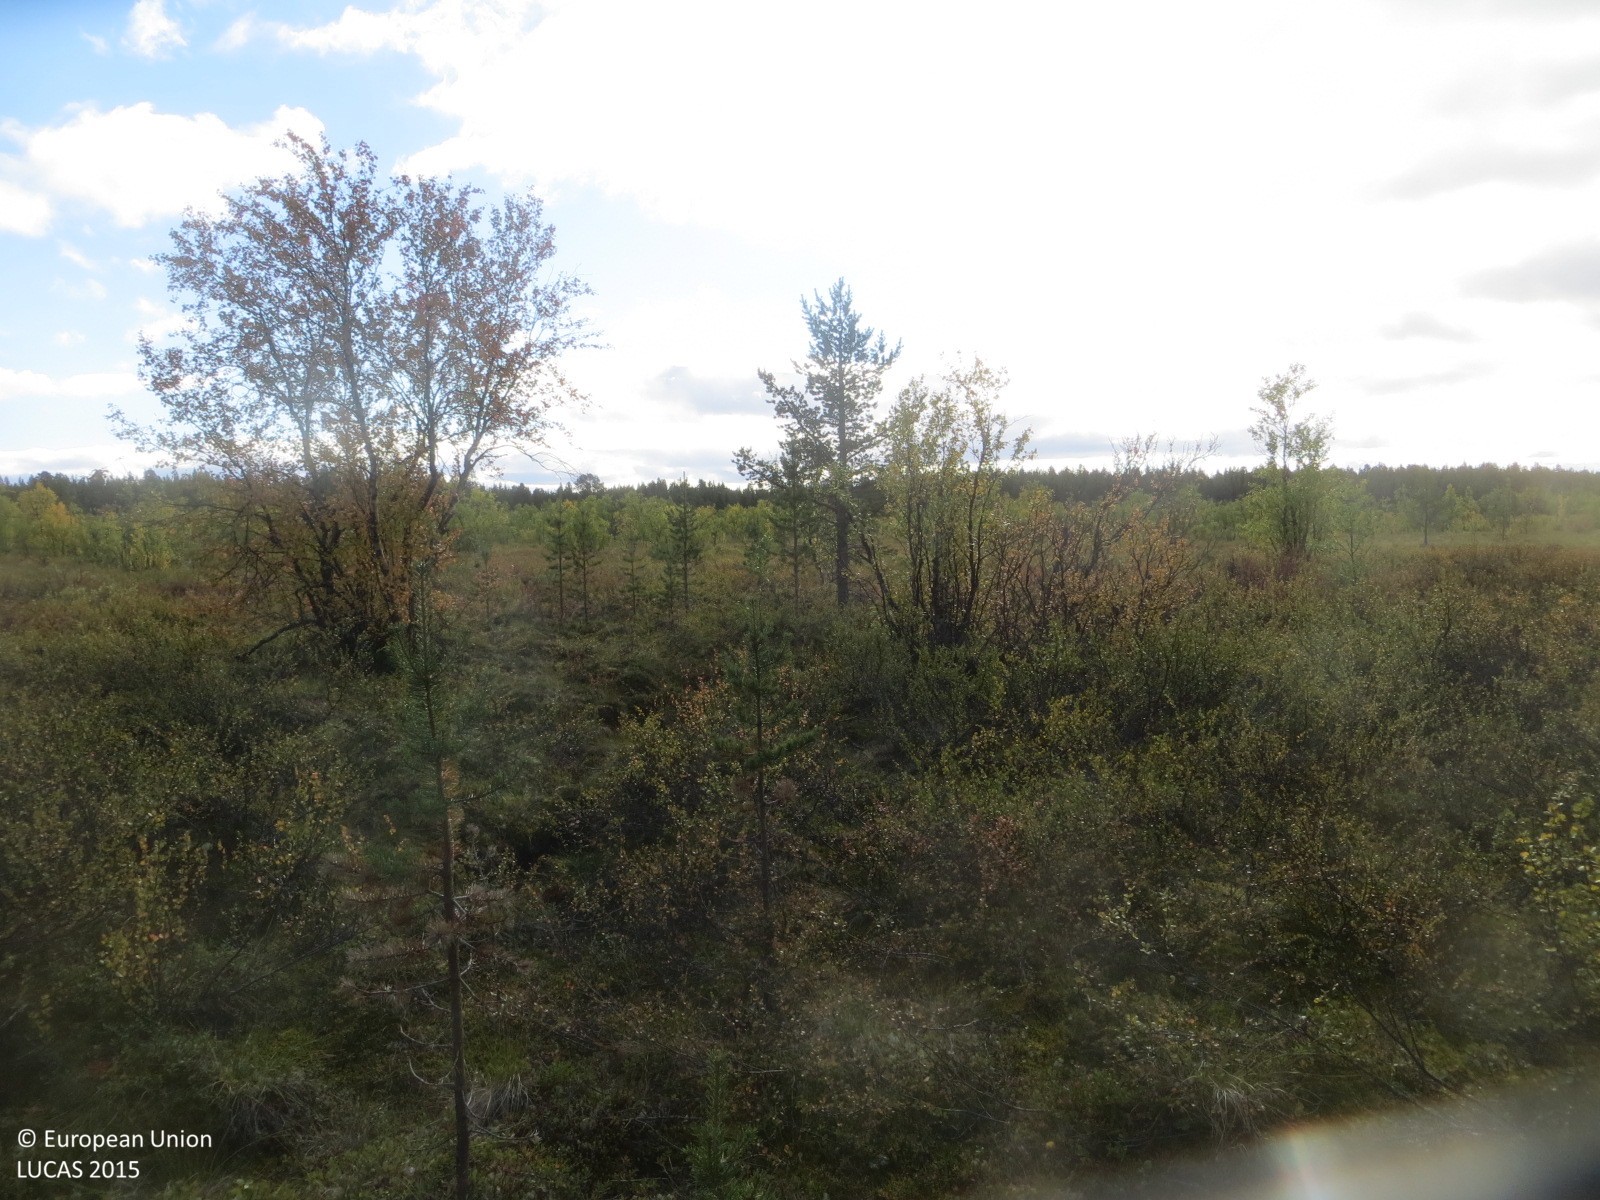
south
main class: Woodland
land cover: Pine dominated mixed woodland
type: boreal forest
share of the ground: 50 - 75 %
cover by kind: shrubs 50 %, broadleaved forest trees 35 %, coniferous forest trees 15 %
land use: Semi-natural and natural areas not in use
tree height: > 5 m
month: September
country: FI
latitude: 68.3999
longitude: 24.3028
